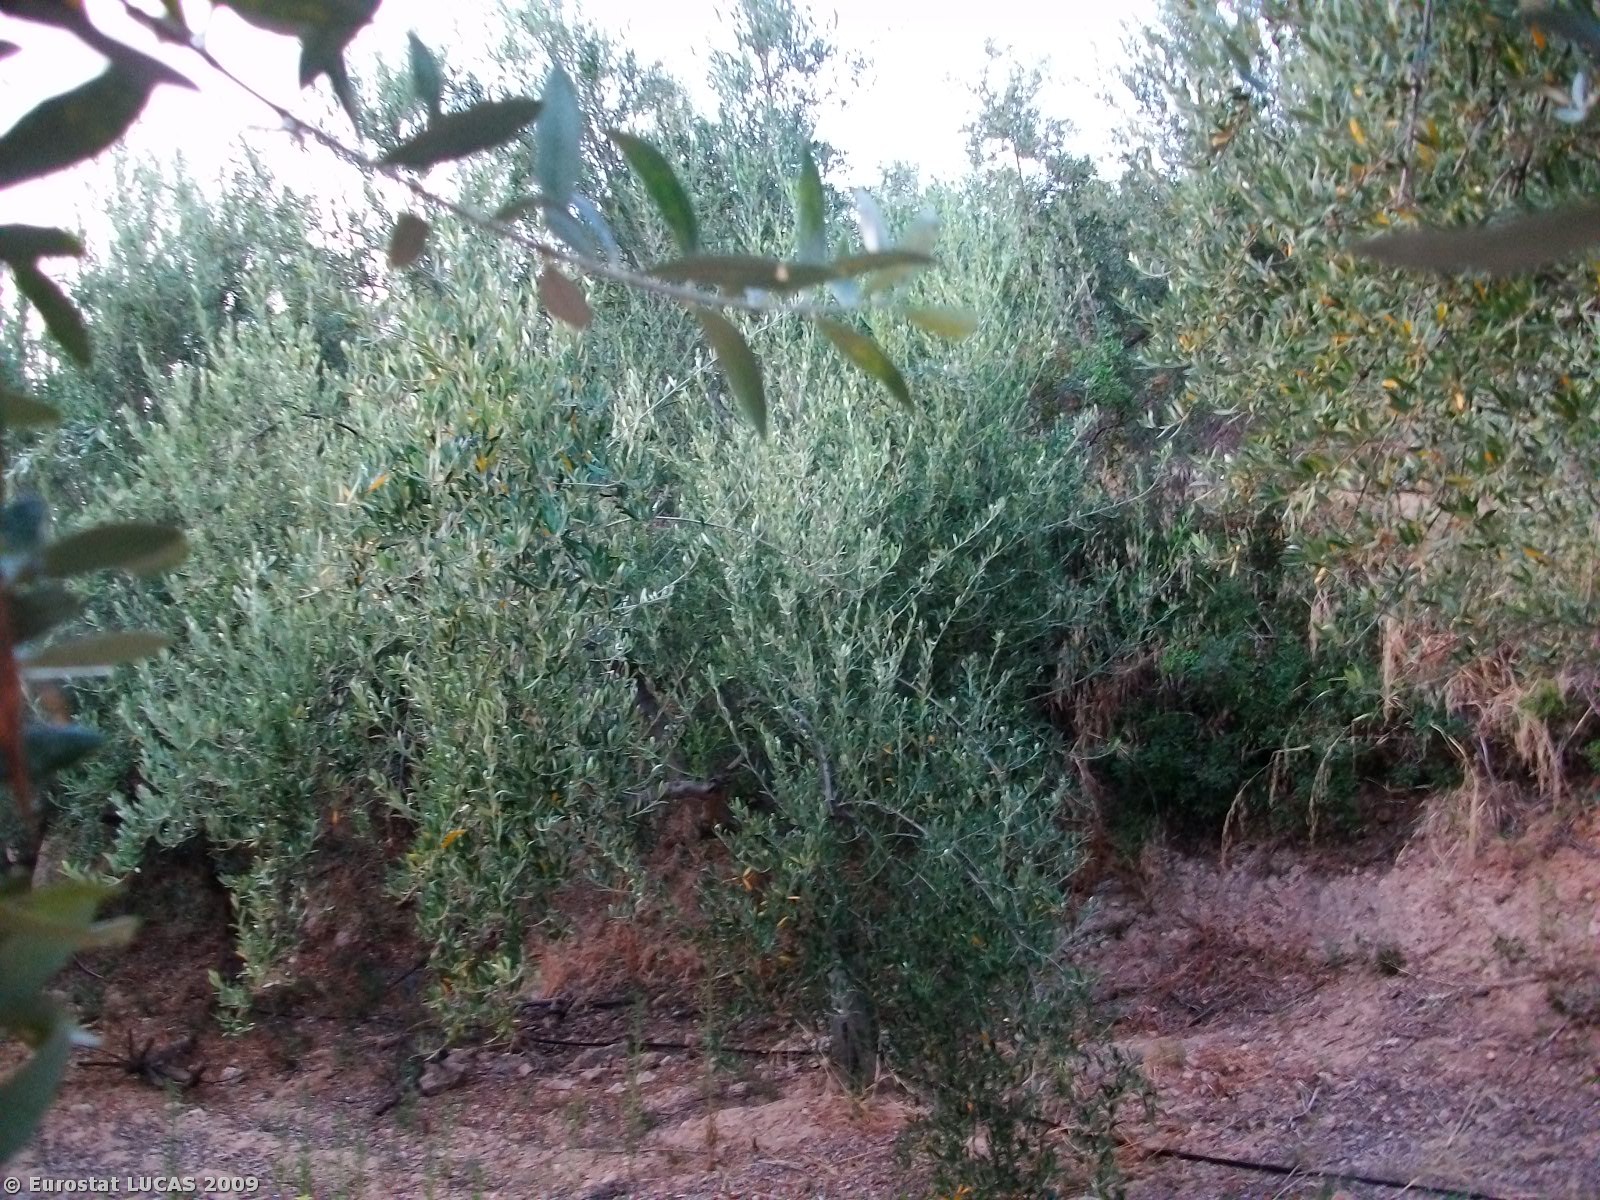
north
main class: Cropland
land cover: Olive groves
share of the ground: 25 - 50 %
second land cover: Bare land
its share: > 75 %
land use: Agriculture (excluding fallow land and kitchen gardens)
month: August
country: GR
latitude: 36.8696
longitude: 22.7321
